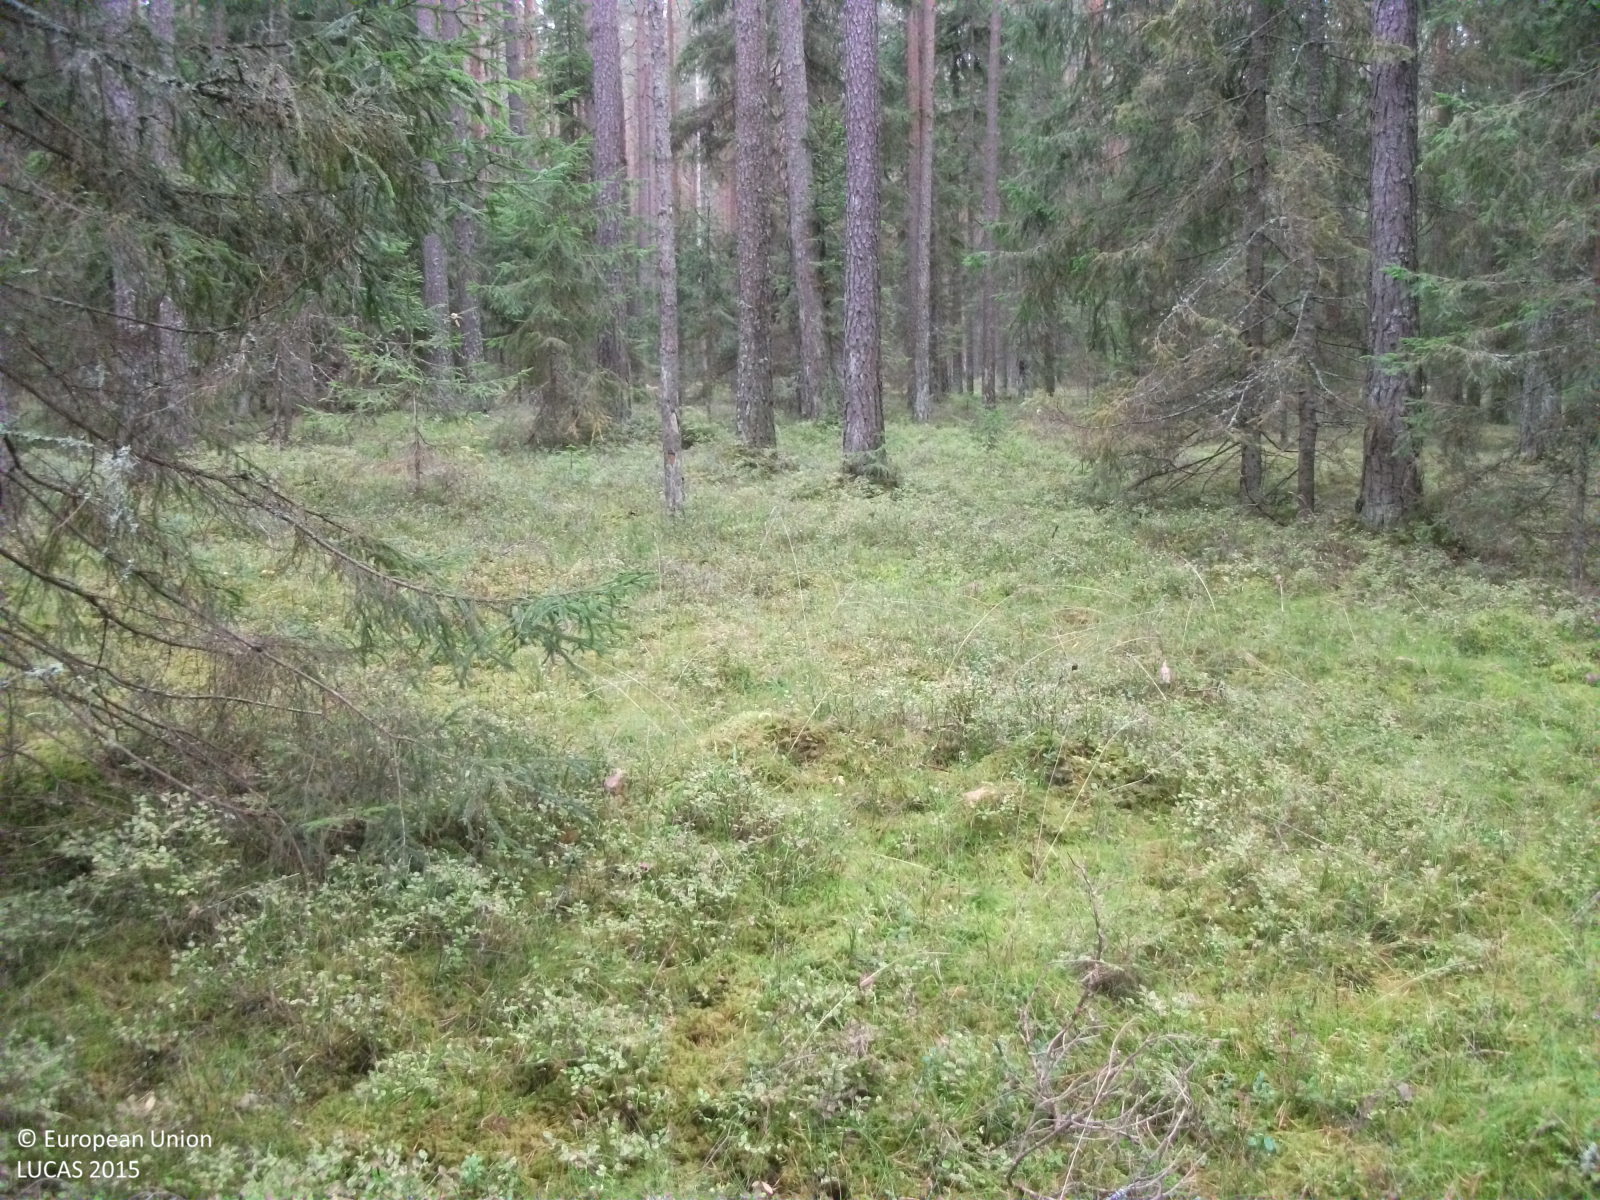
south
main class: Woodland
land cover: Other coniferous woodland
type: hemiboreal forest and nemoral coniferous forest and mixed broadleaved-coniferous forest
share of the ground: > 75 %
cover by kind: coniferous forest trees 80 %, lichens and mosses 15 %, herbaceous plants 5 %
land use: Forestry
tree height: > 5 m
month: September
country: LV
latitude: 57.7263
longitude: 24.4451
